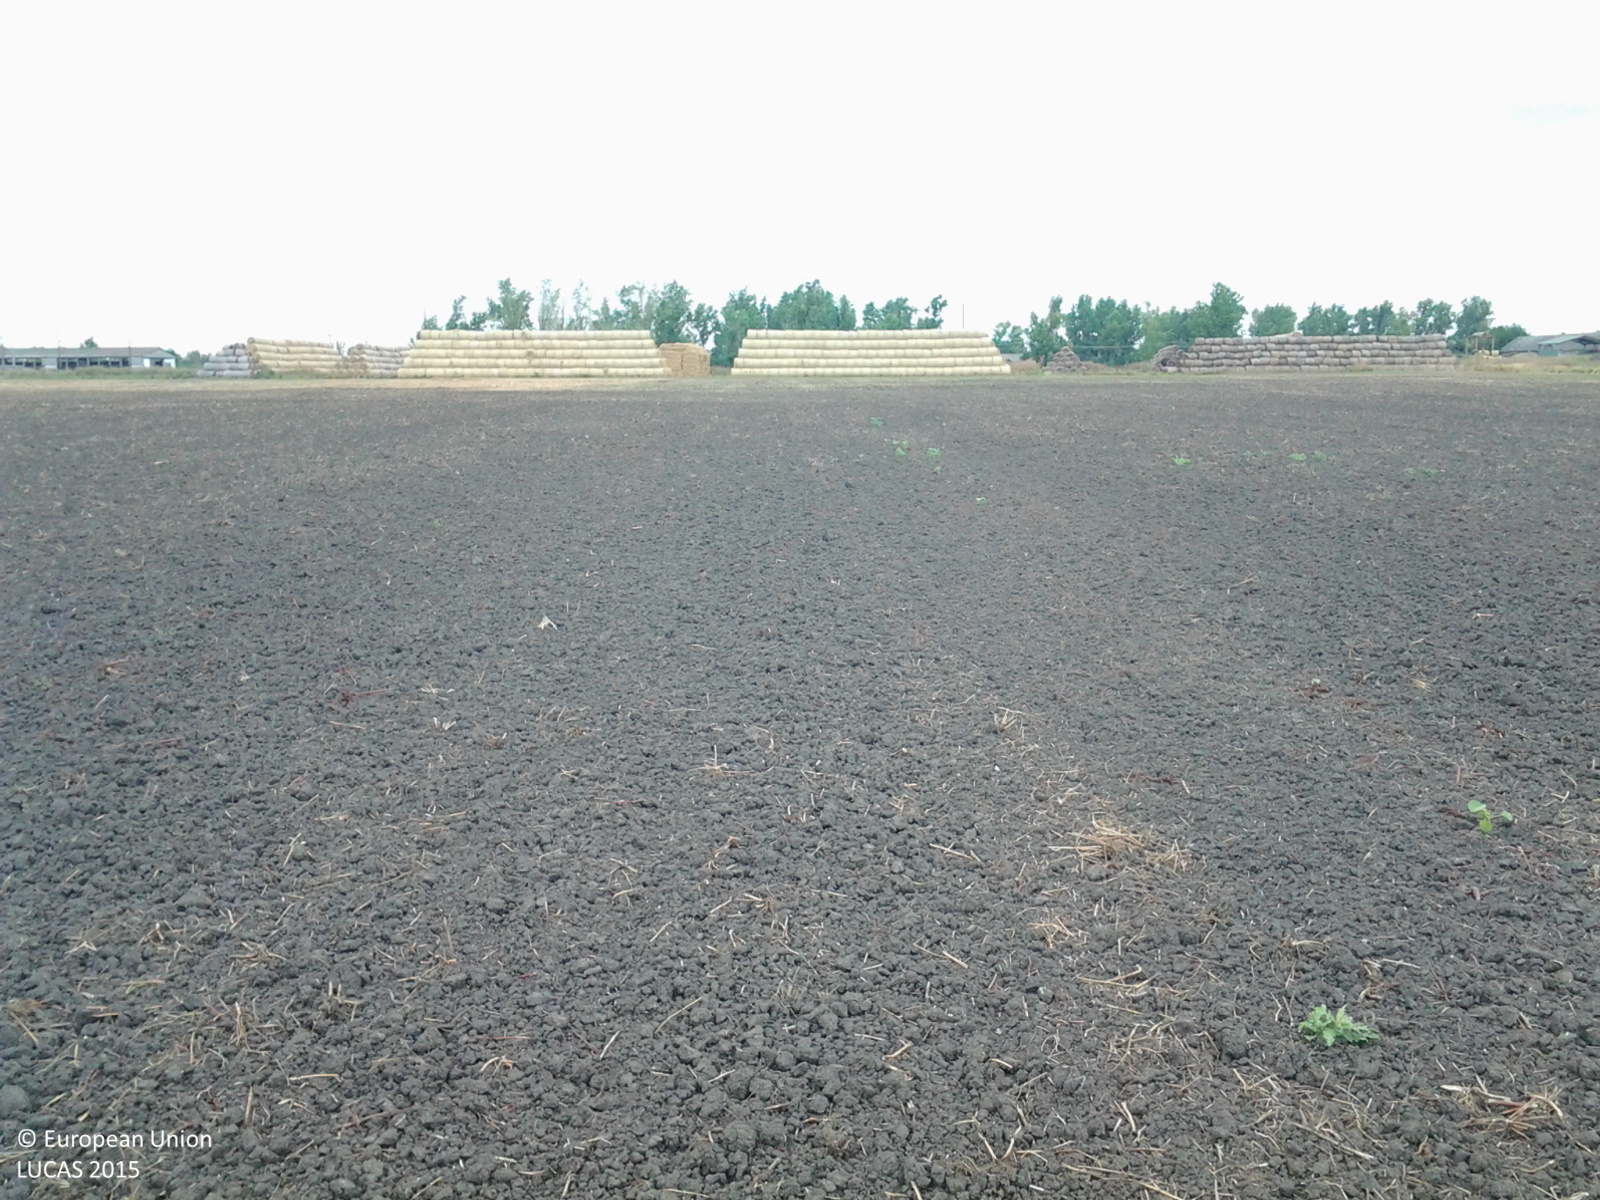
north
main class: Cropland
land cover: Common wheat
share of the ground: < 10 %
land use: Agriculture (excluding fallow land and kitchen gardens)
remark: Harvested field
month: July
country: HU
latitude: 47.1464
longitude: 20.6200
